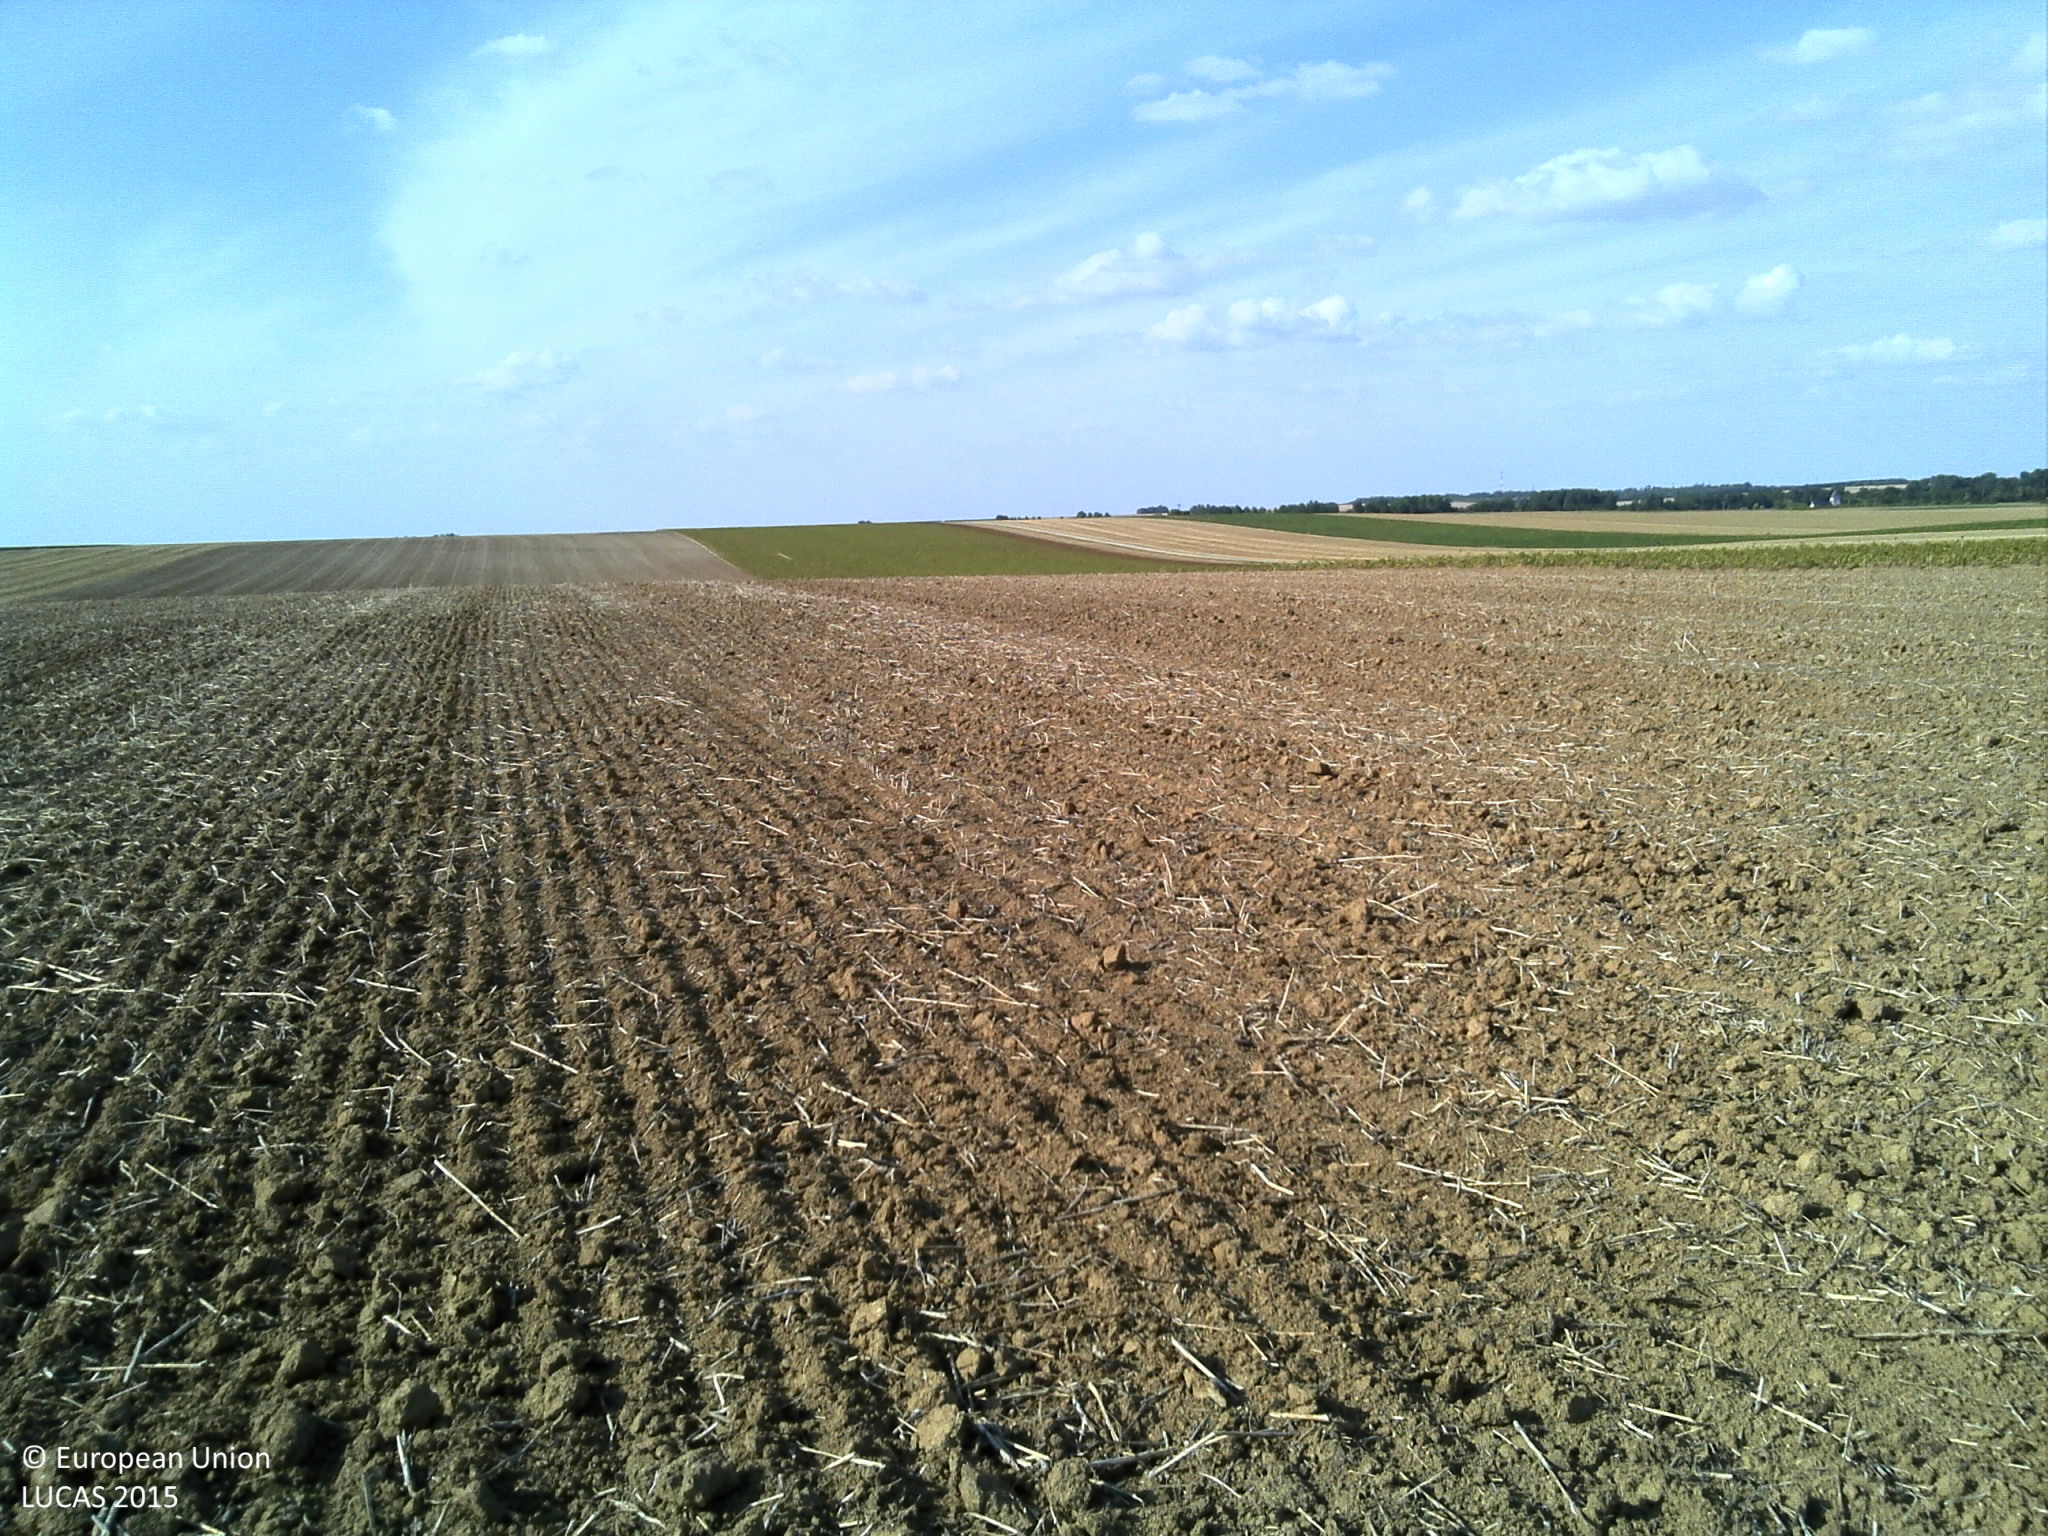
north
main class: Cropland
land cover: Rape and turnip rape
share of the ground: > 75 %
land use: Agriculture (excluding fallow land and kitchen gardens)
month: August
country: FR
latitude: 48.9722
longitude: 4.5460
